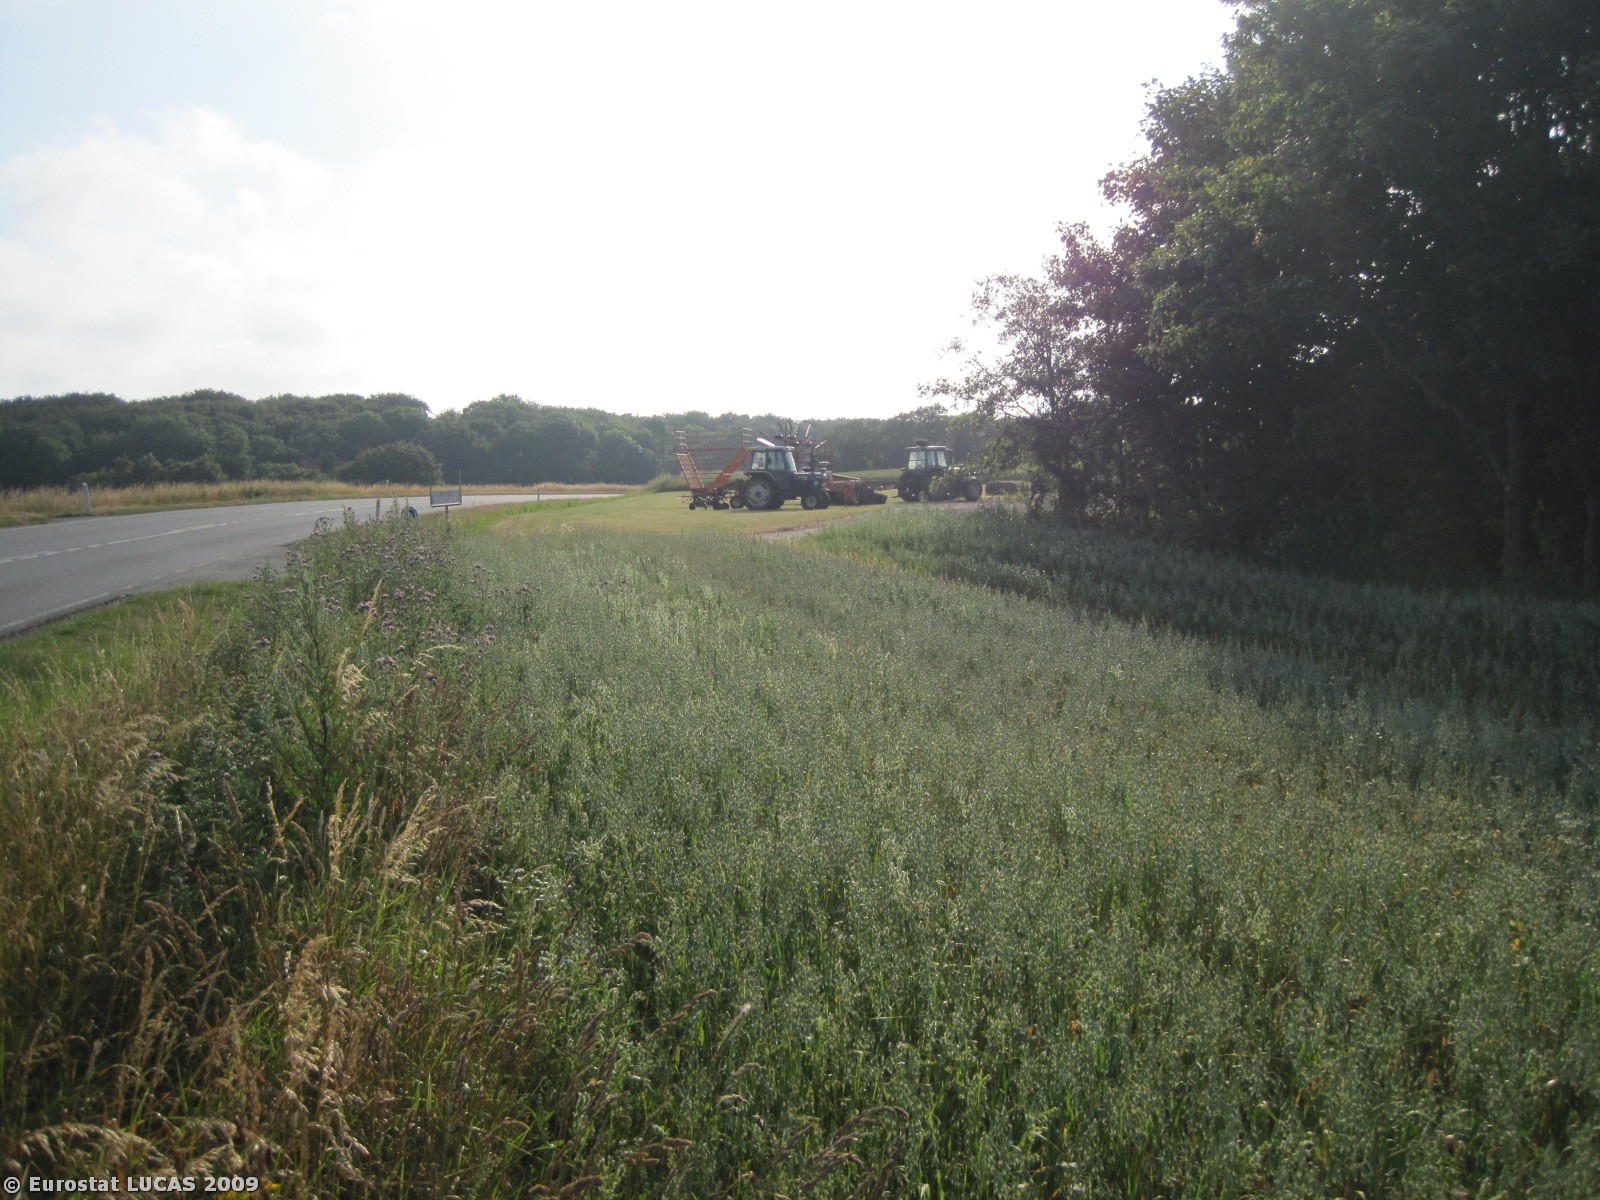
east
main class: Grassland
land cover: Grassland without tree/shrub cover
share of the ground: > 75 %
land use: Unused
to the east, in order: Grassland without tree/shrub cover; Oats; Grass margins; Broadleaved woodland; Grassland without tree/shrub cover; Artificial constructions in urban areas; Common wheat; Grass margins; Broadleaved woodland; Grass margins; Common wheat
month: July
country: DK
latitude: 56.4514
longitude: 8.7523
